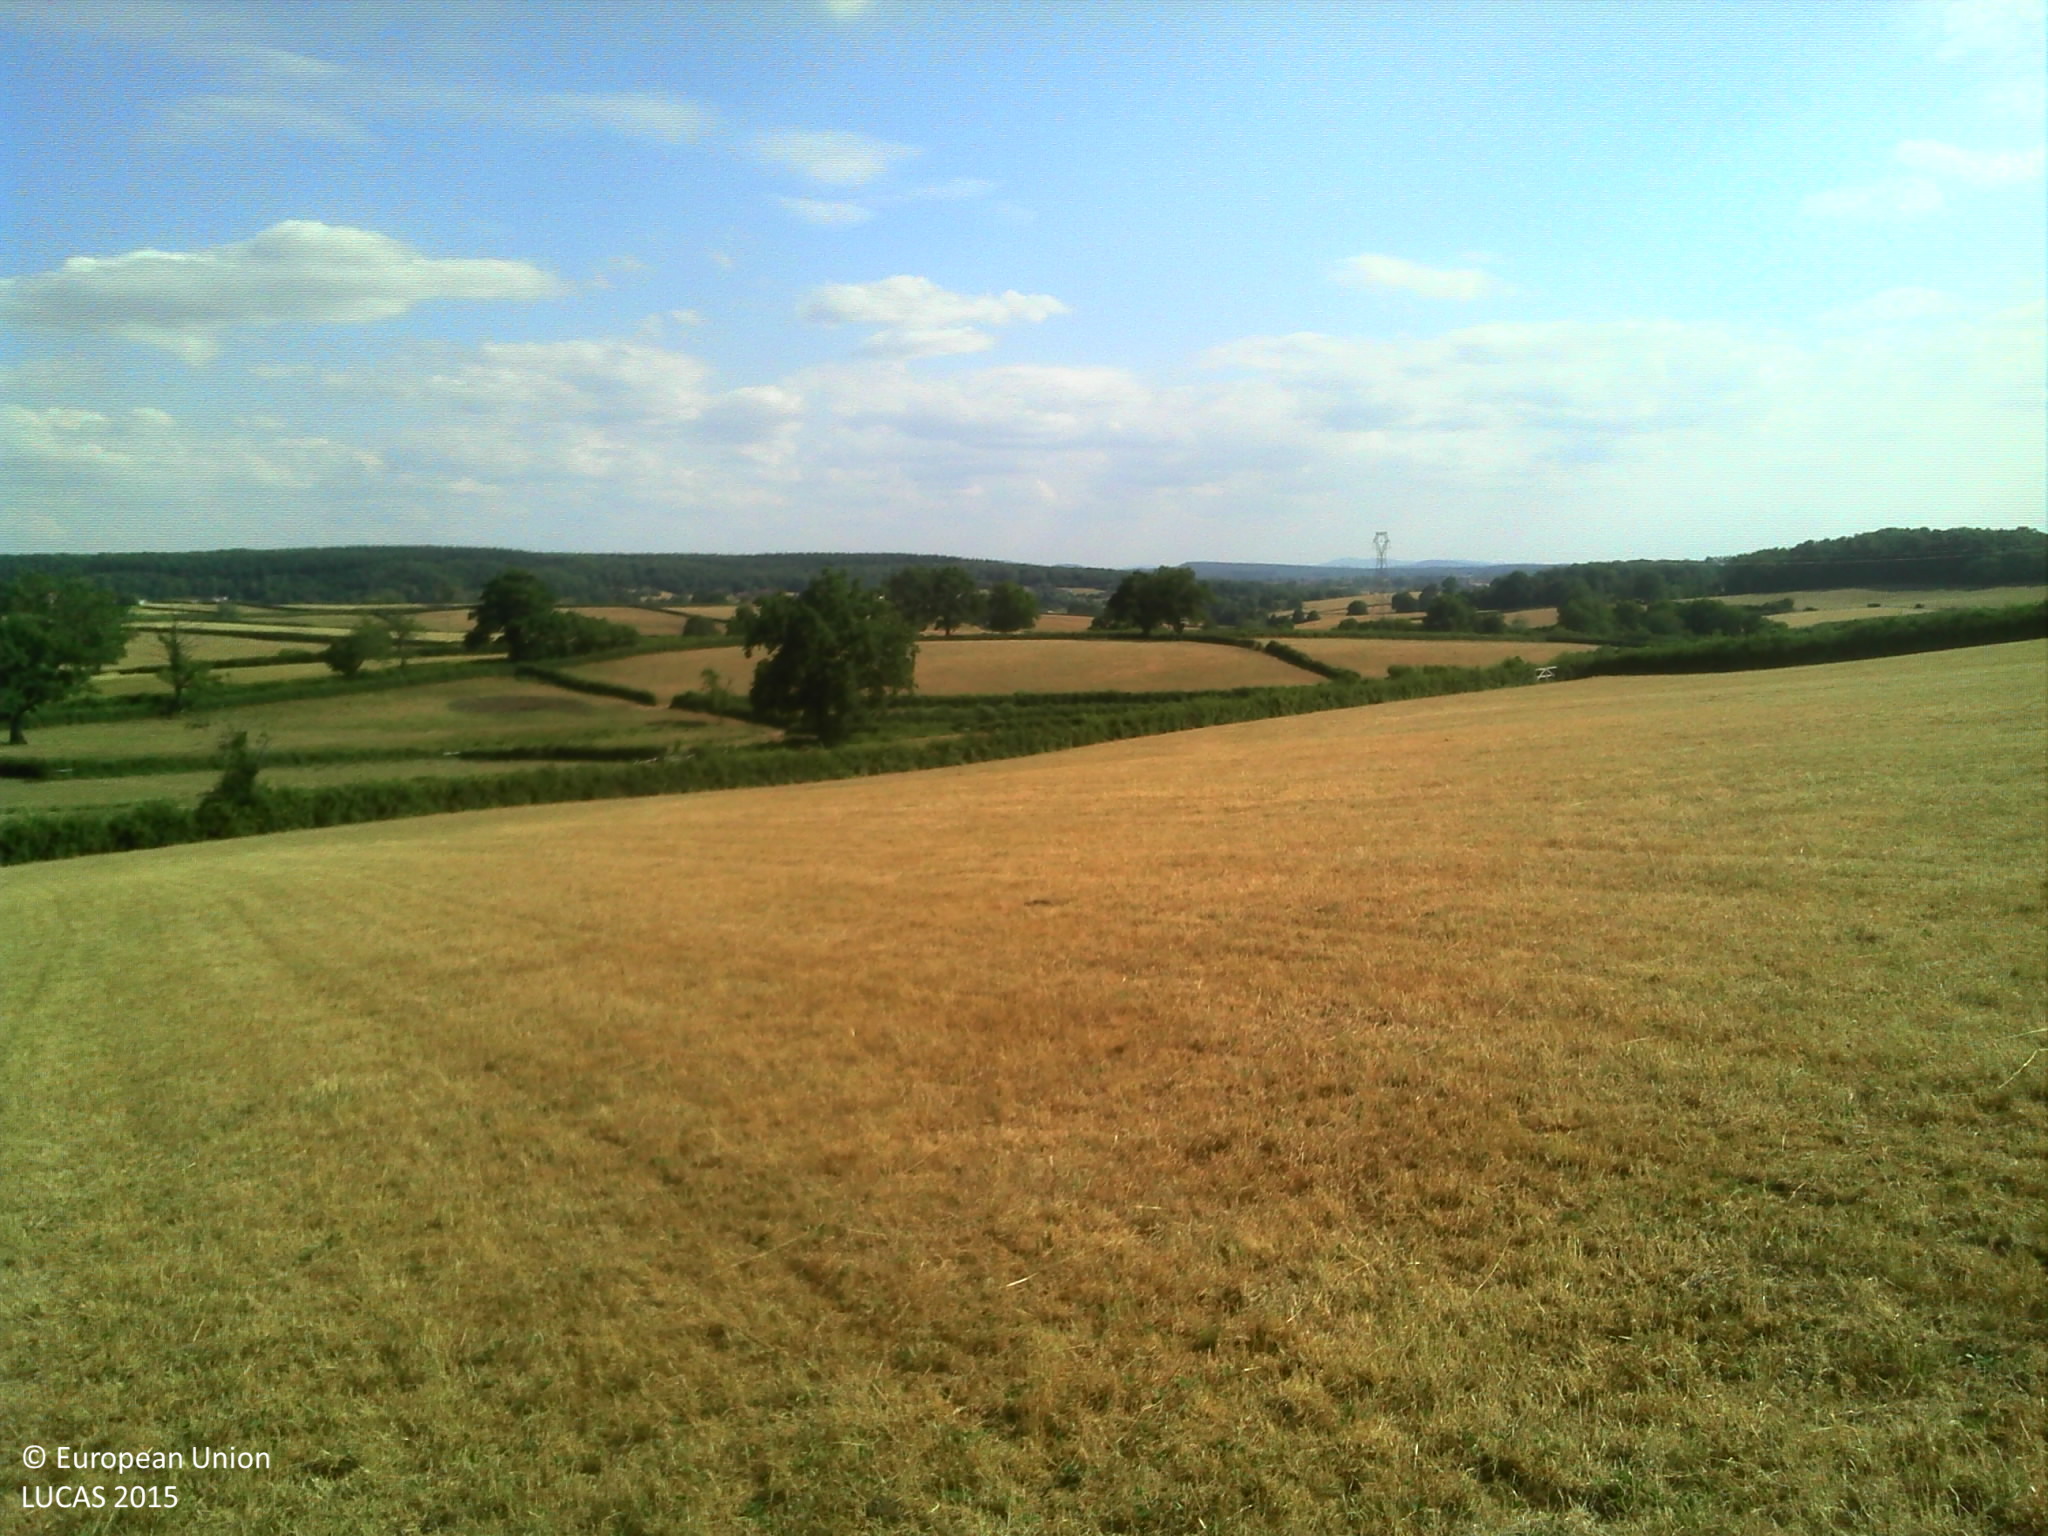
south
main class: Grassland
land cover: Grassland without tree/shrub cover
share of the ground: > 75 %
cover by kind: herbaceous plants 100 %
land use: Agriculture (excluding fallow land and kitchen gardens)
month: July
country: FR
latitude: 46.5837
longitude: 4.4024
